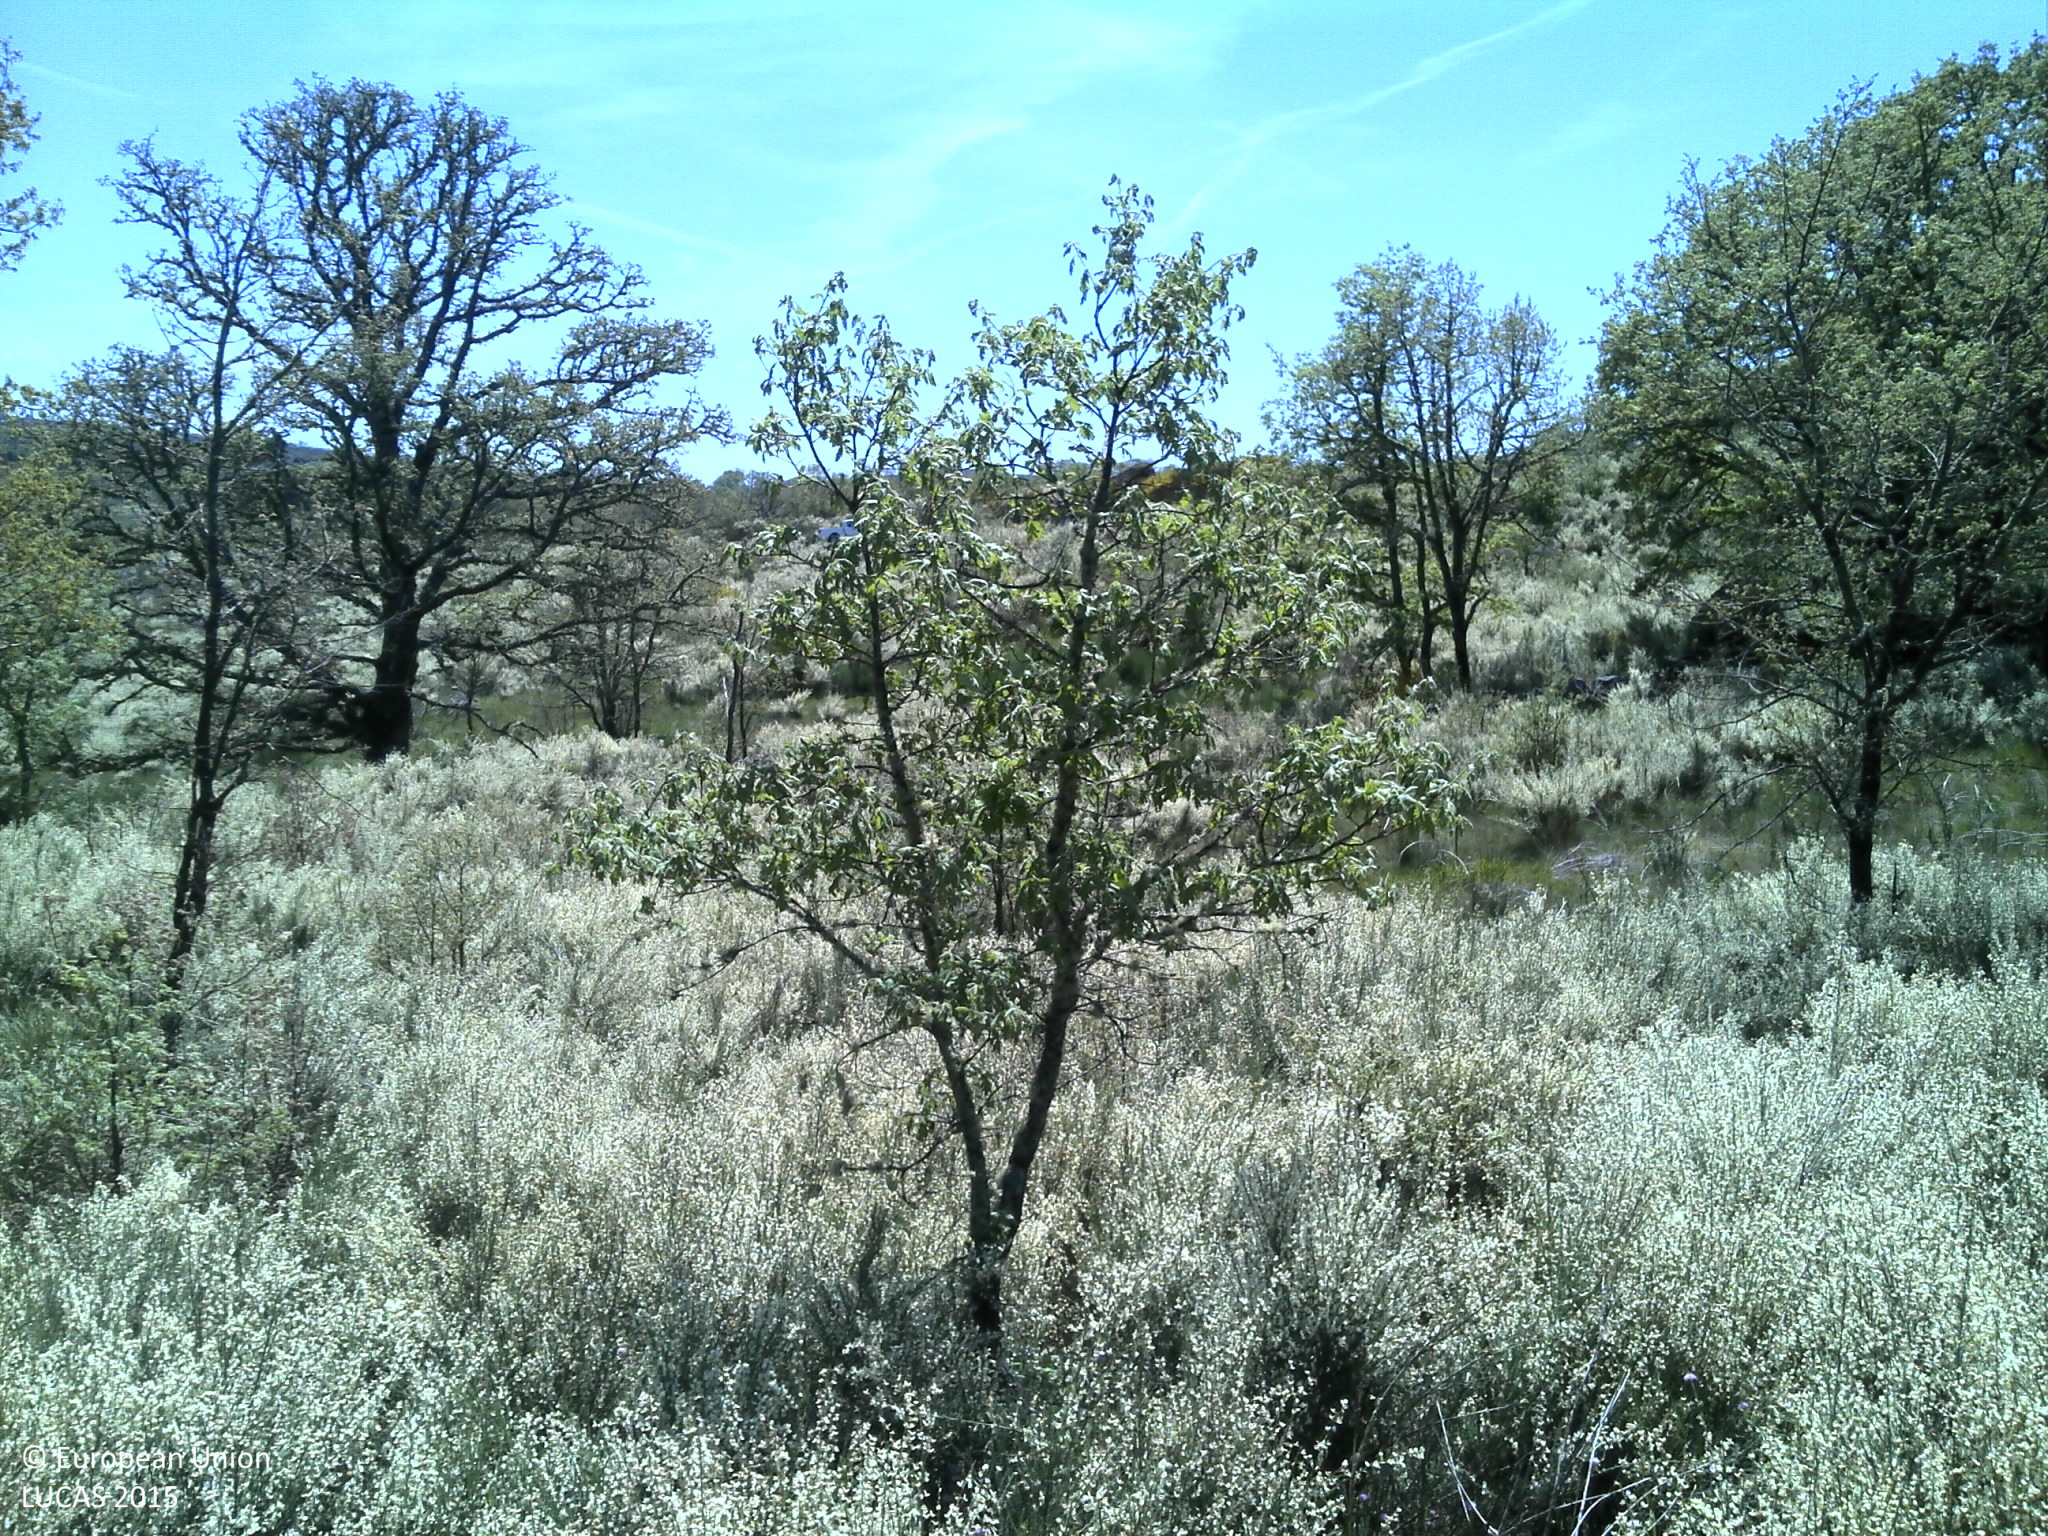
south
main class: Shrubland
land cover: Shrubland with sparse tree cover
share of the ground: 50 - 75 %
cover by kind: shrubs 75 %, unconsolidated bare surface 20 %, broadleaved forest trees 5 %
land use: Semi-natural and natural areas not in use
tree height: < 5 m
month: May
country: PT
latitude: 41.0279
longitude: -7.8870
